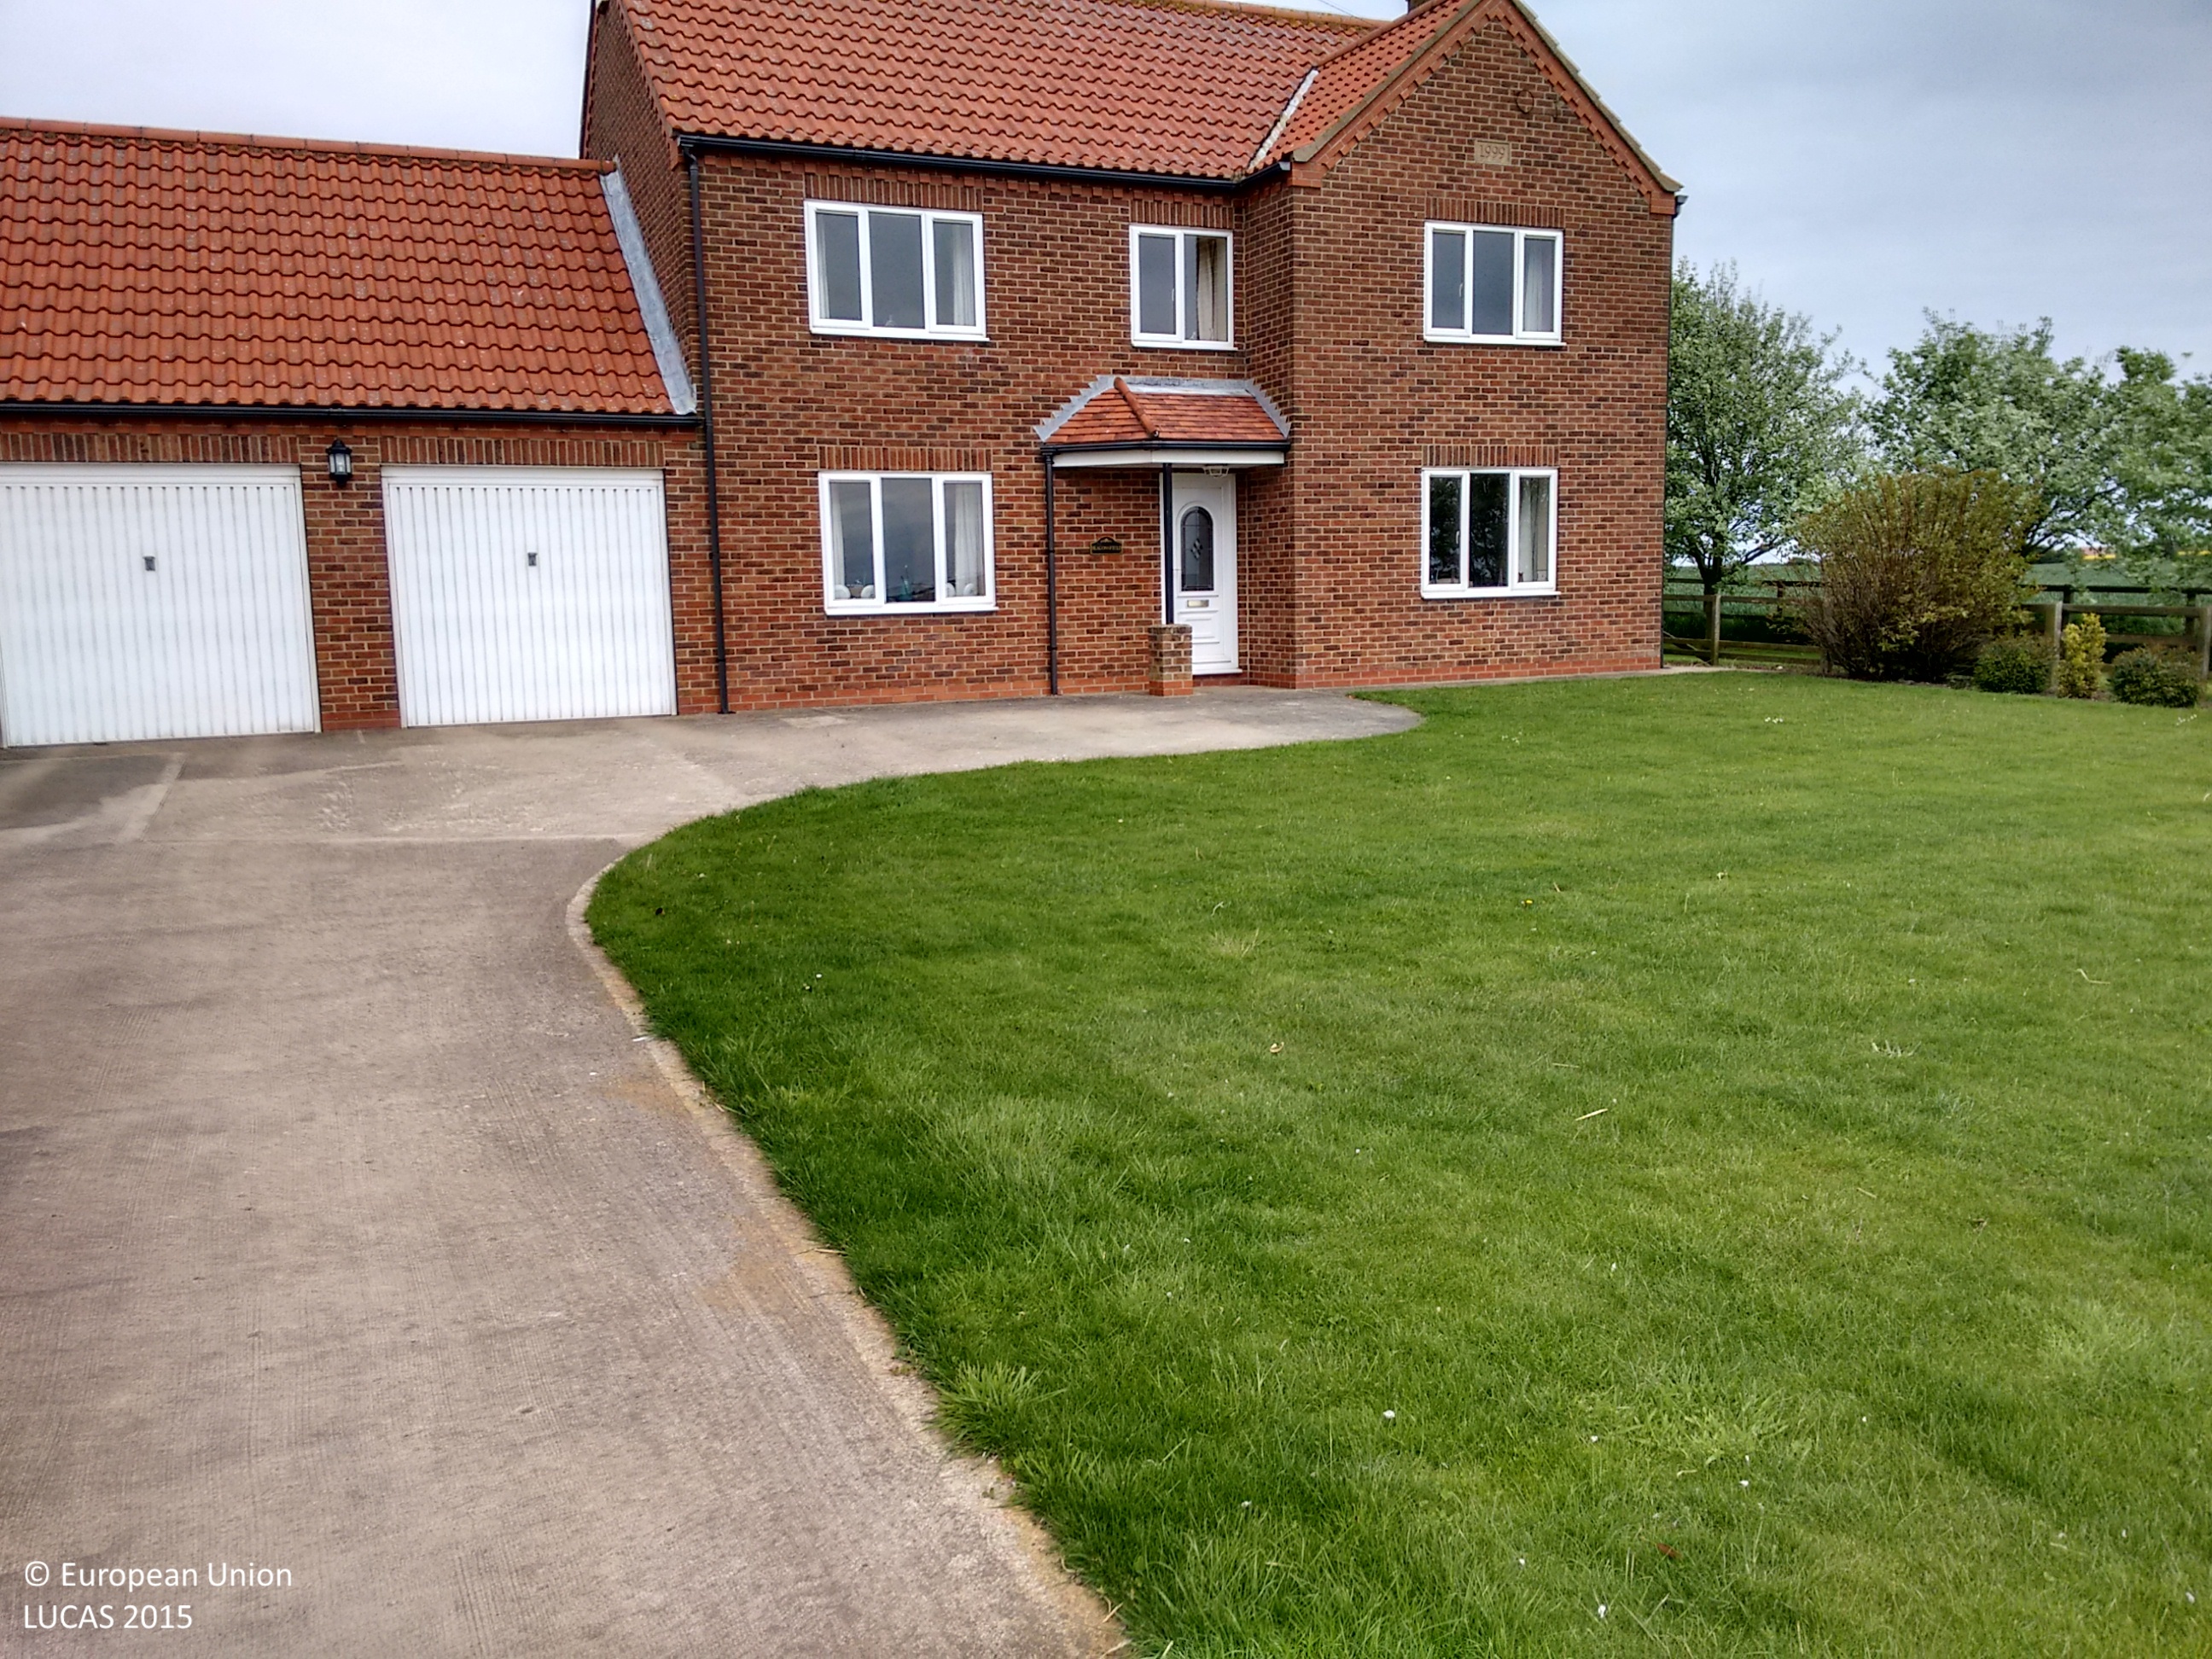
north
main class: Grassland
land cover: Grassland without tree/shrub cover
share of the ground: > 75 %
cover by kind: herbaceous plants 100 %
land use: Residential
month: May
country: GB
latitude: 53.8299
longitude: -0.1058
